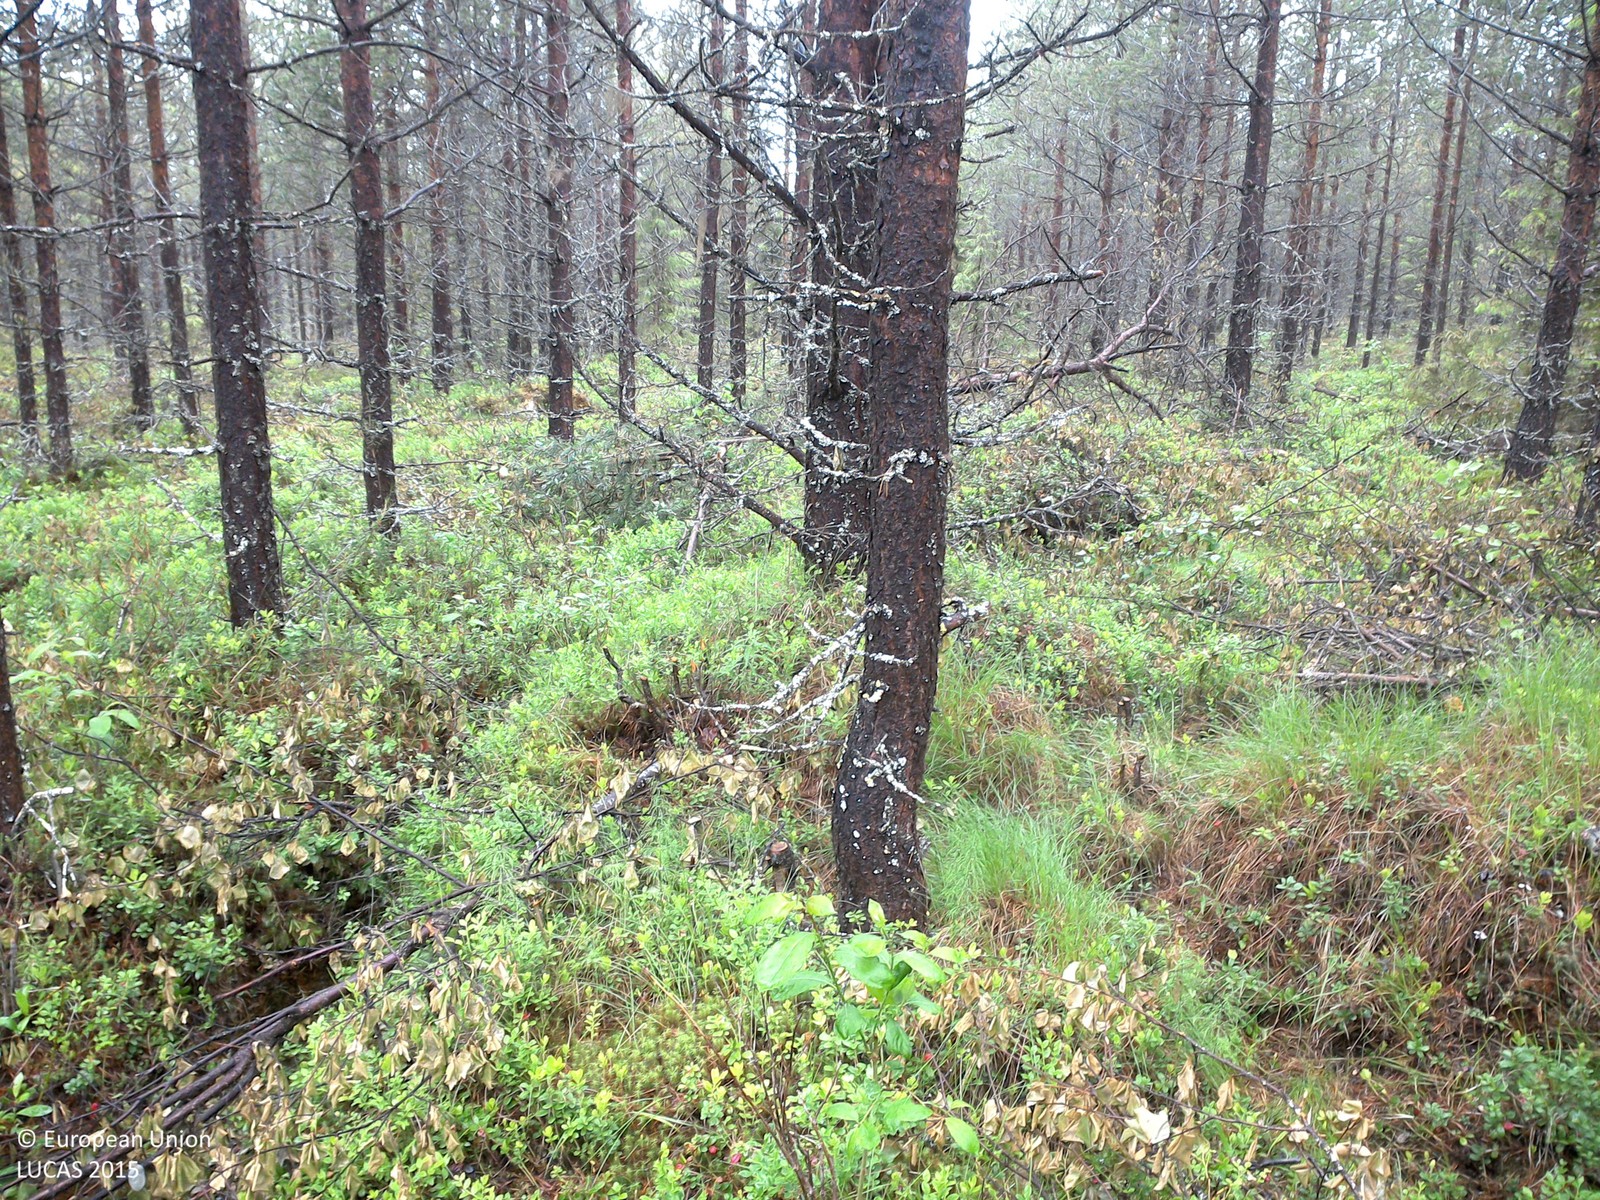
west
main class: Woodland
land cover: Pine dominated coniferous woodland
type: boreal forest
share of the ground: 25 - 50 %
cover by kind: shrubs 50 %, coniferous forest trees 40 %, herbaceous plants 5 %, lichens and mosses 5 %
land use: Forestry
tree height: > 5 m
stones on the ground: < 10 %
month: July
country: SE
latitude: 66.9756
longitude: 23.6110
